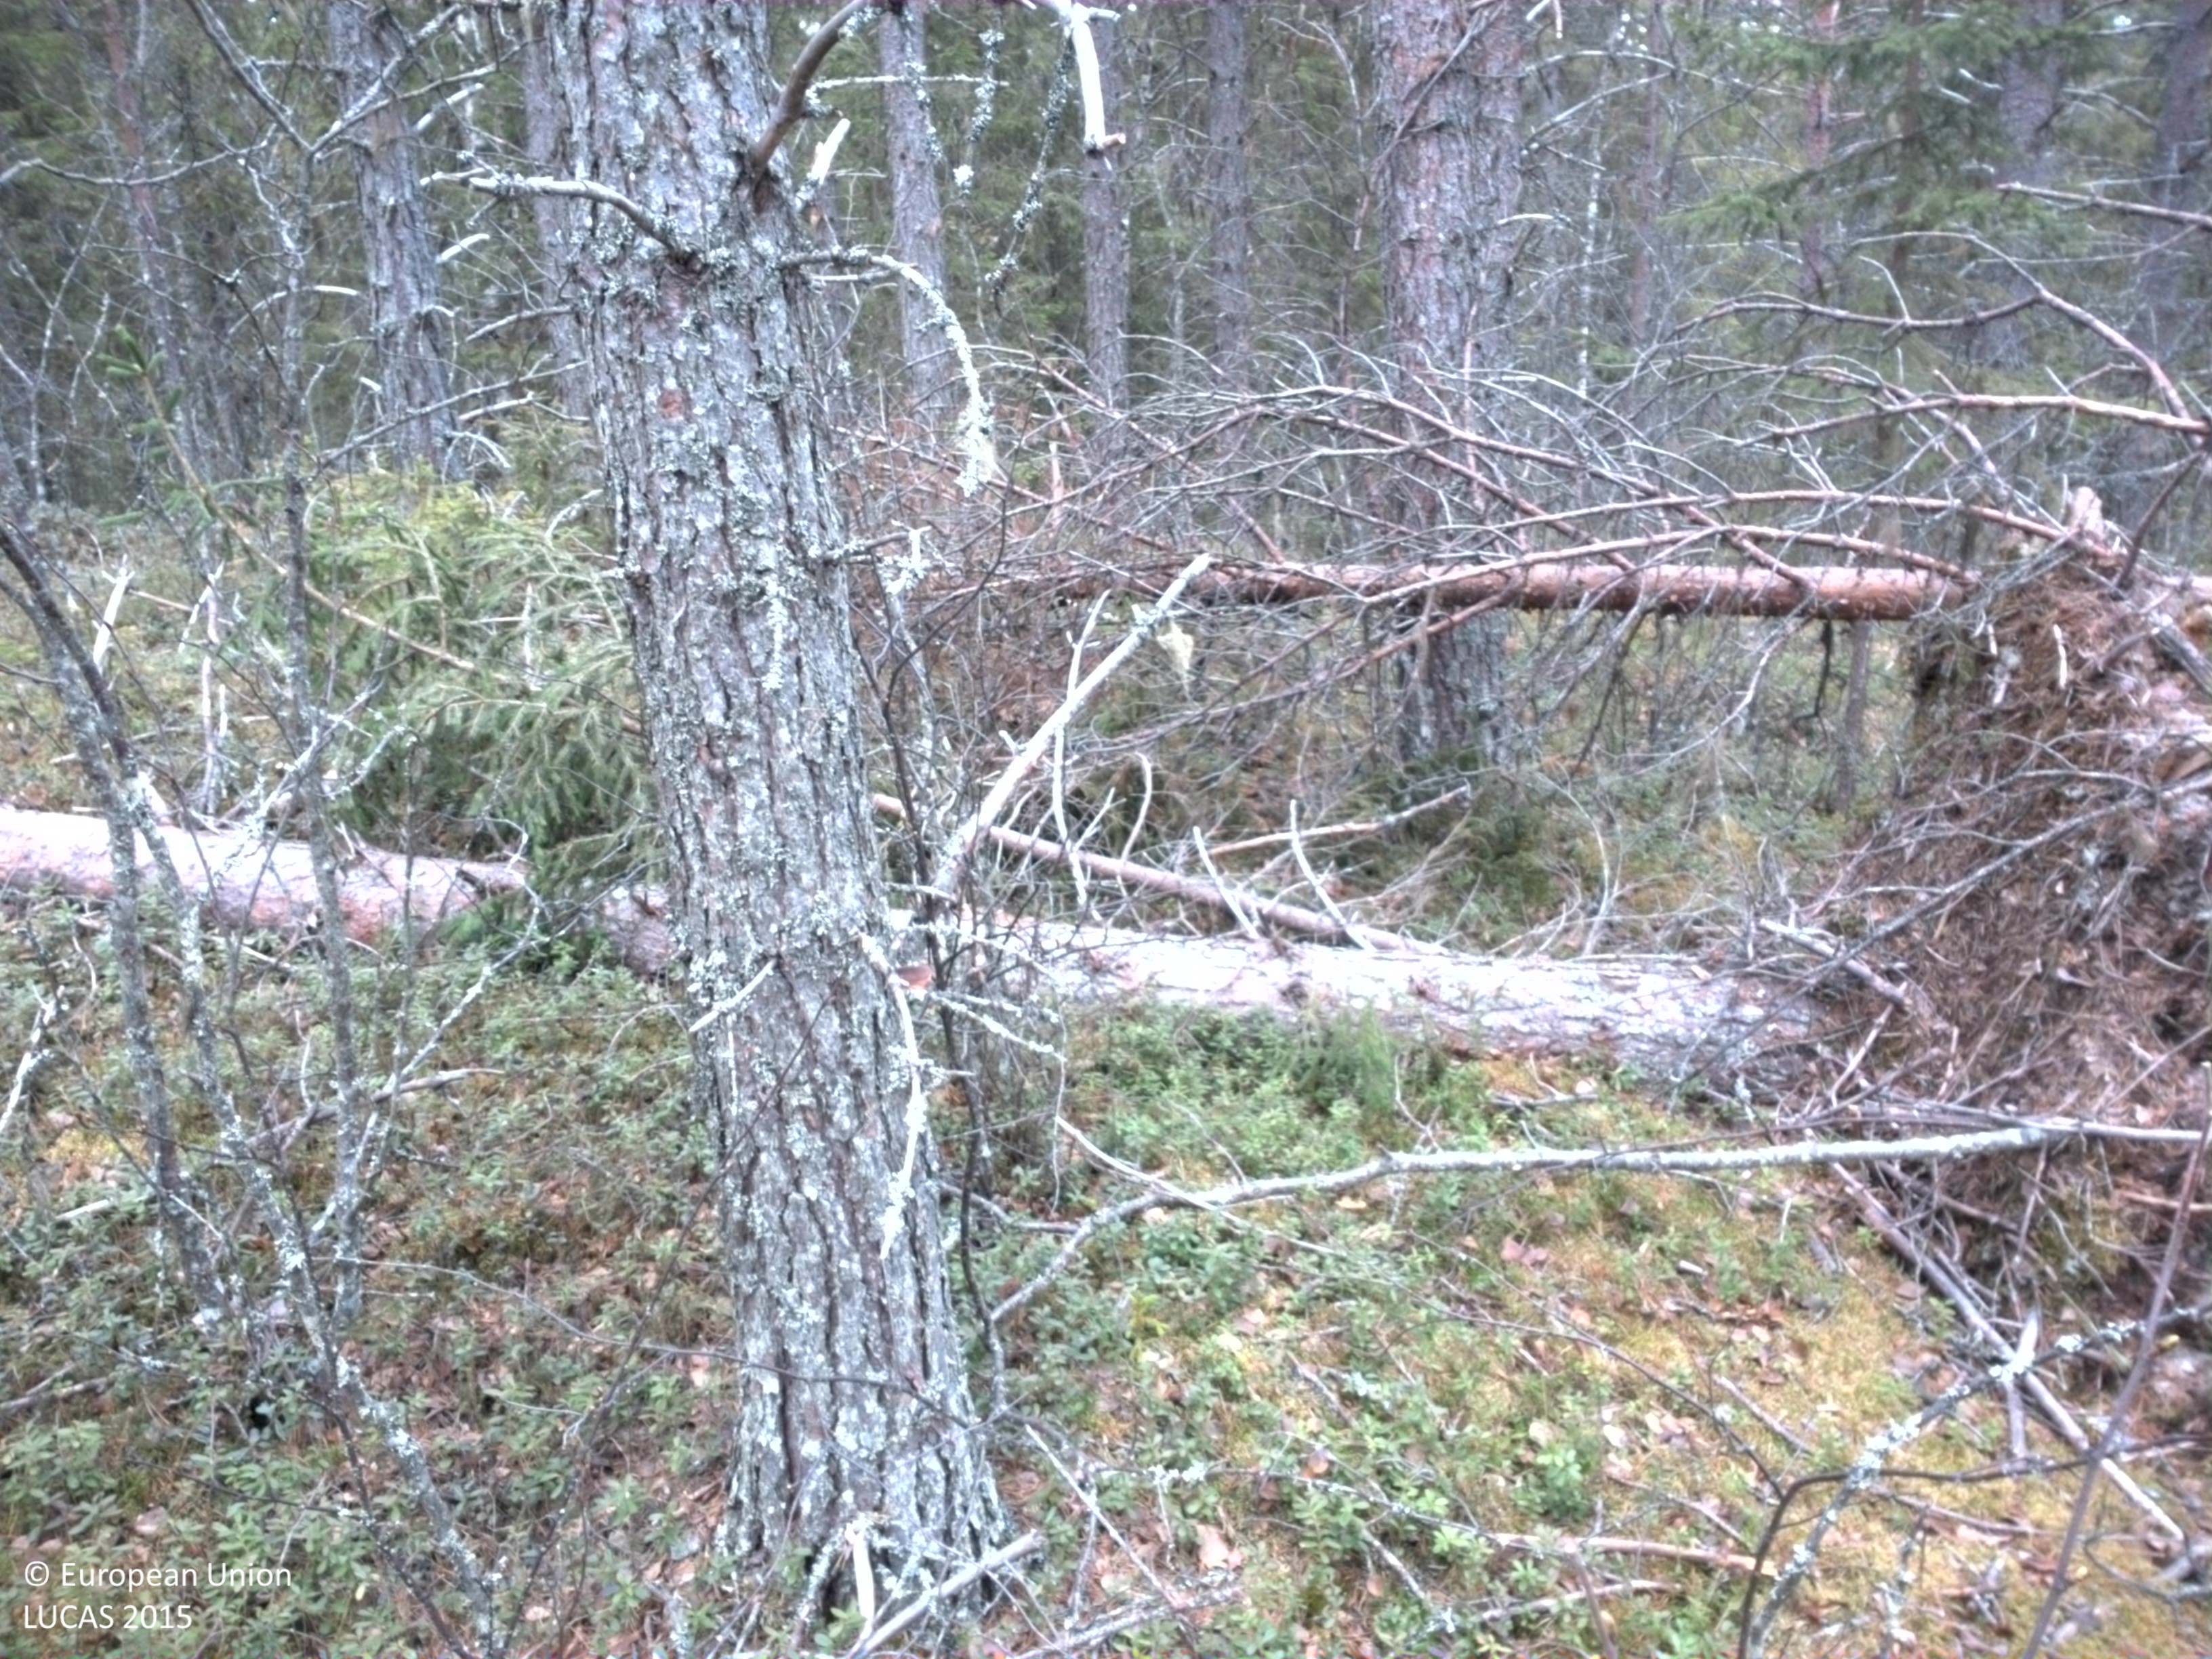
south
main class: Woodland
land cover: Pine dominated coniferous woodland
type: boreal forest
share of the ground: 25 - 50 %
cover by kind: coniferous forest trees 40 %, lichens and mosses 30 %, herbaceous plants 20 %, broadleaved forest trees 10 %
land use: Forestry
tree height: > 5 m
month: May
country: SE
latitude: 64.2943
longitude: 18.2141
